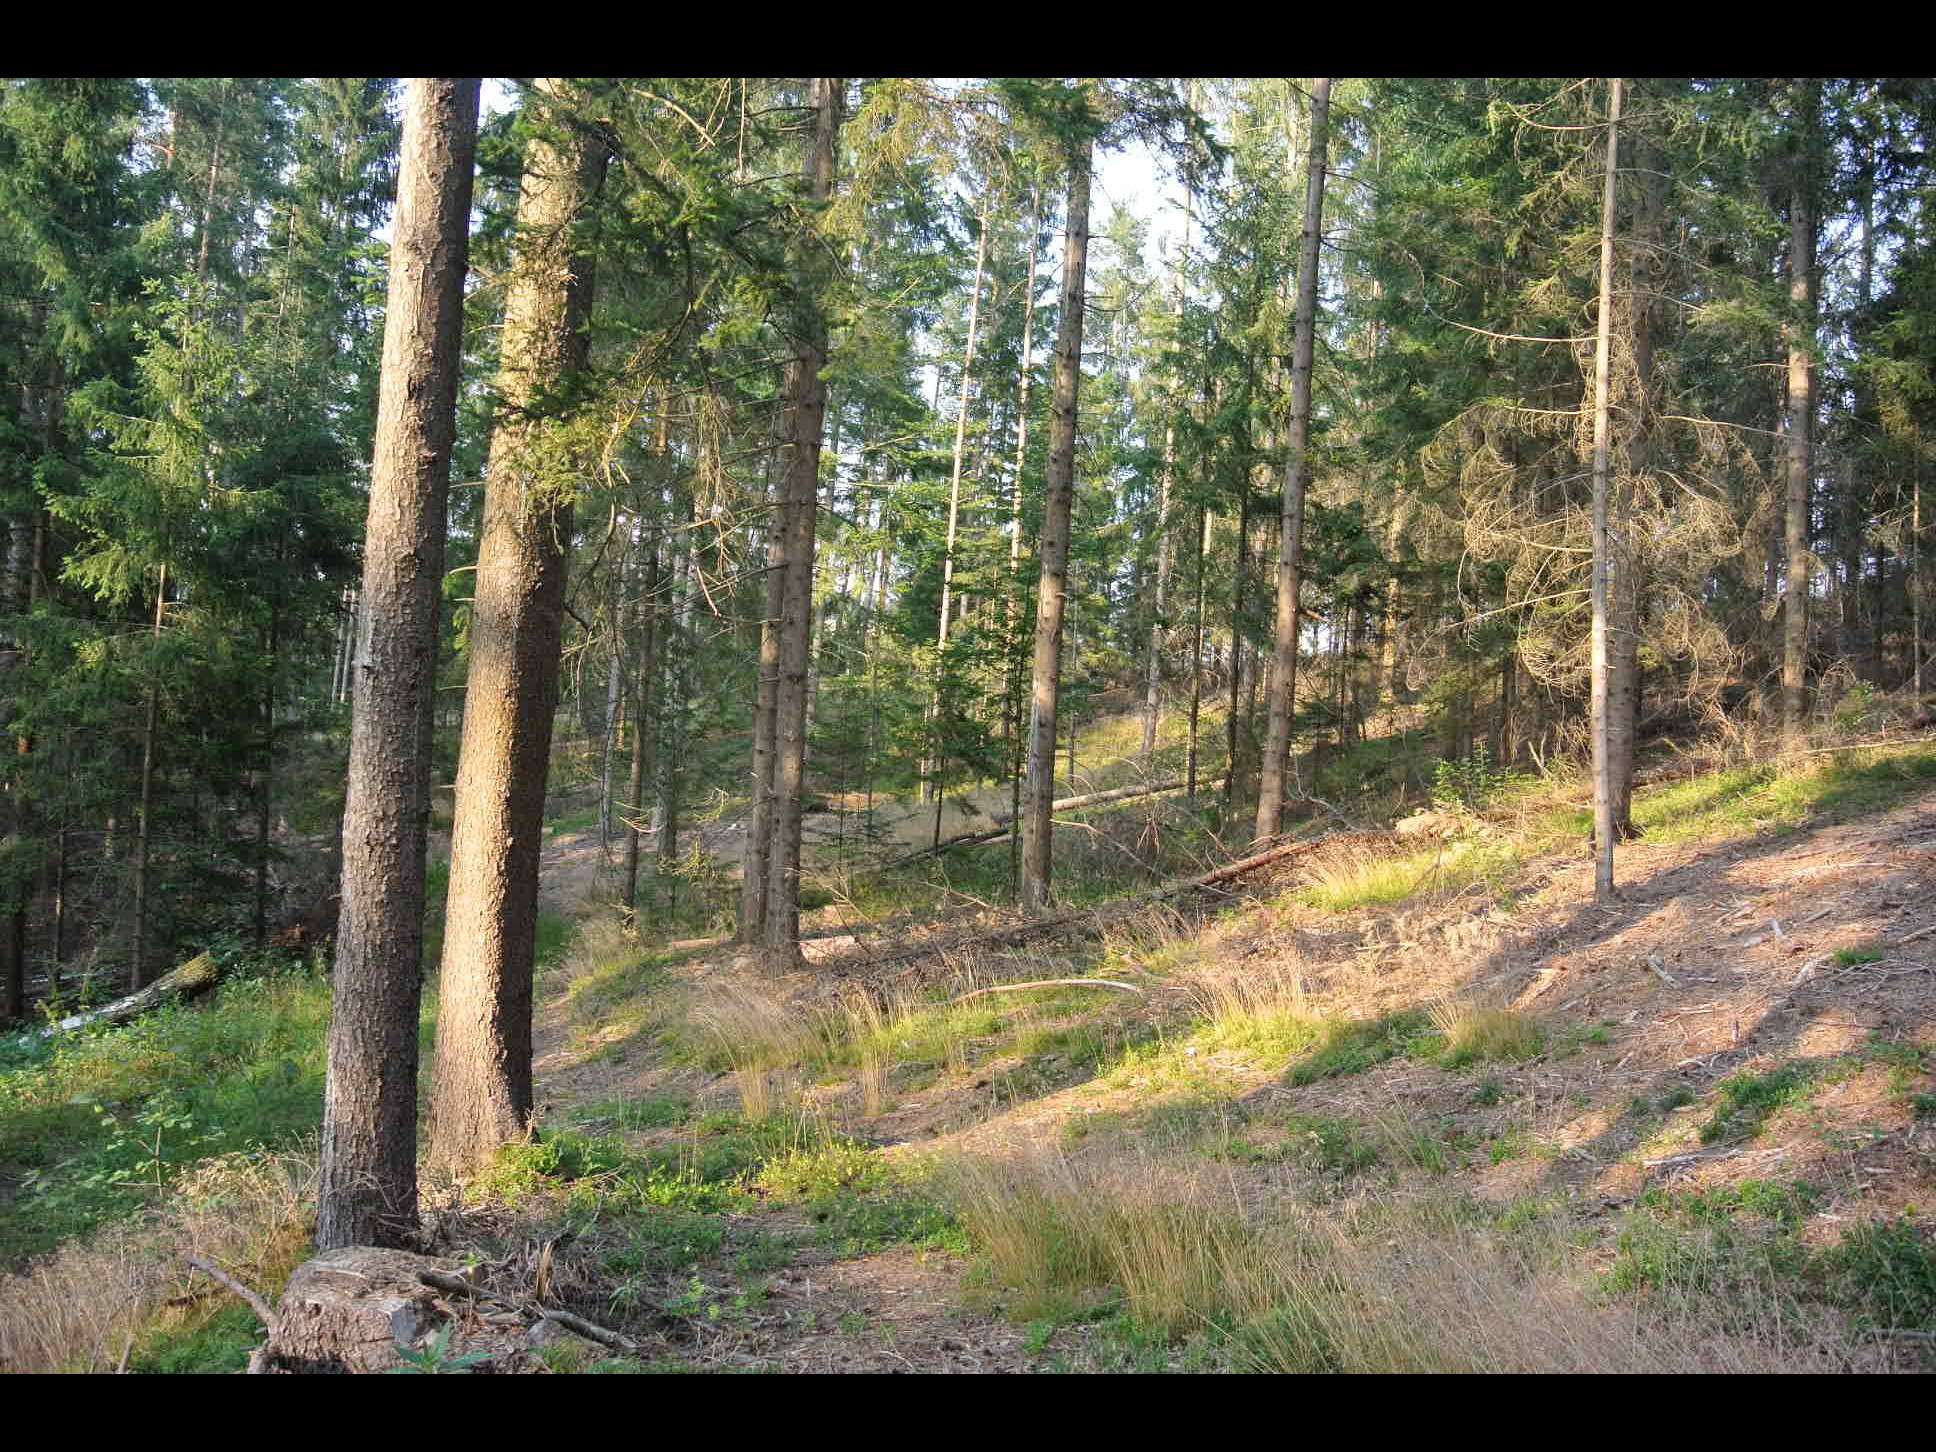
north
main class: Woodland
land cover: Other coniferous woodland
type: alpine coniferous forest
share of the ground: > 75 %
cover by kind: coniferous forest trees 100 %
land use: Forestry
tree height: > 5 m
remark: Clear cut
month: July
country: AT
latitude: 47.5119
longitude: 16.1238
